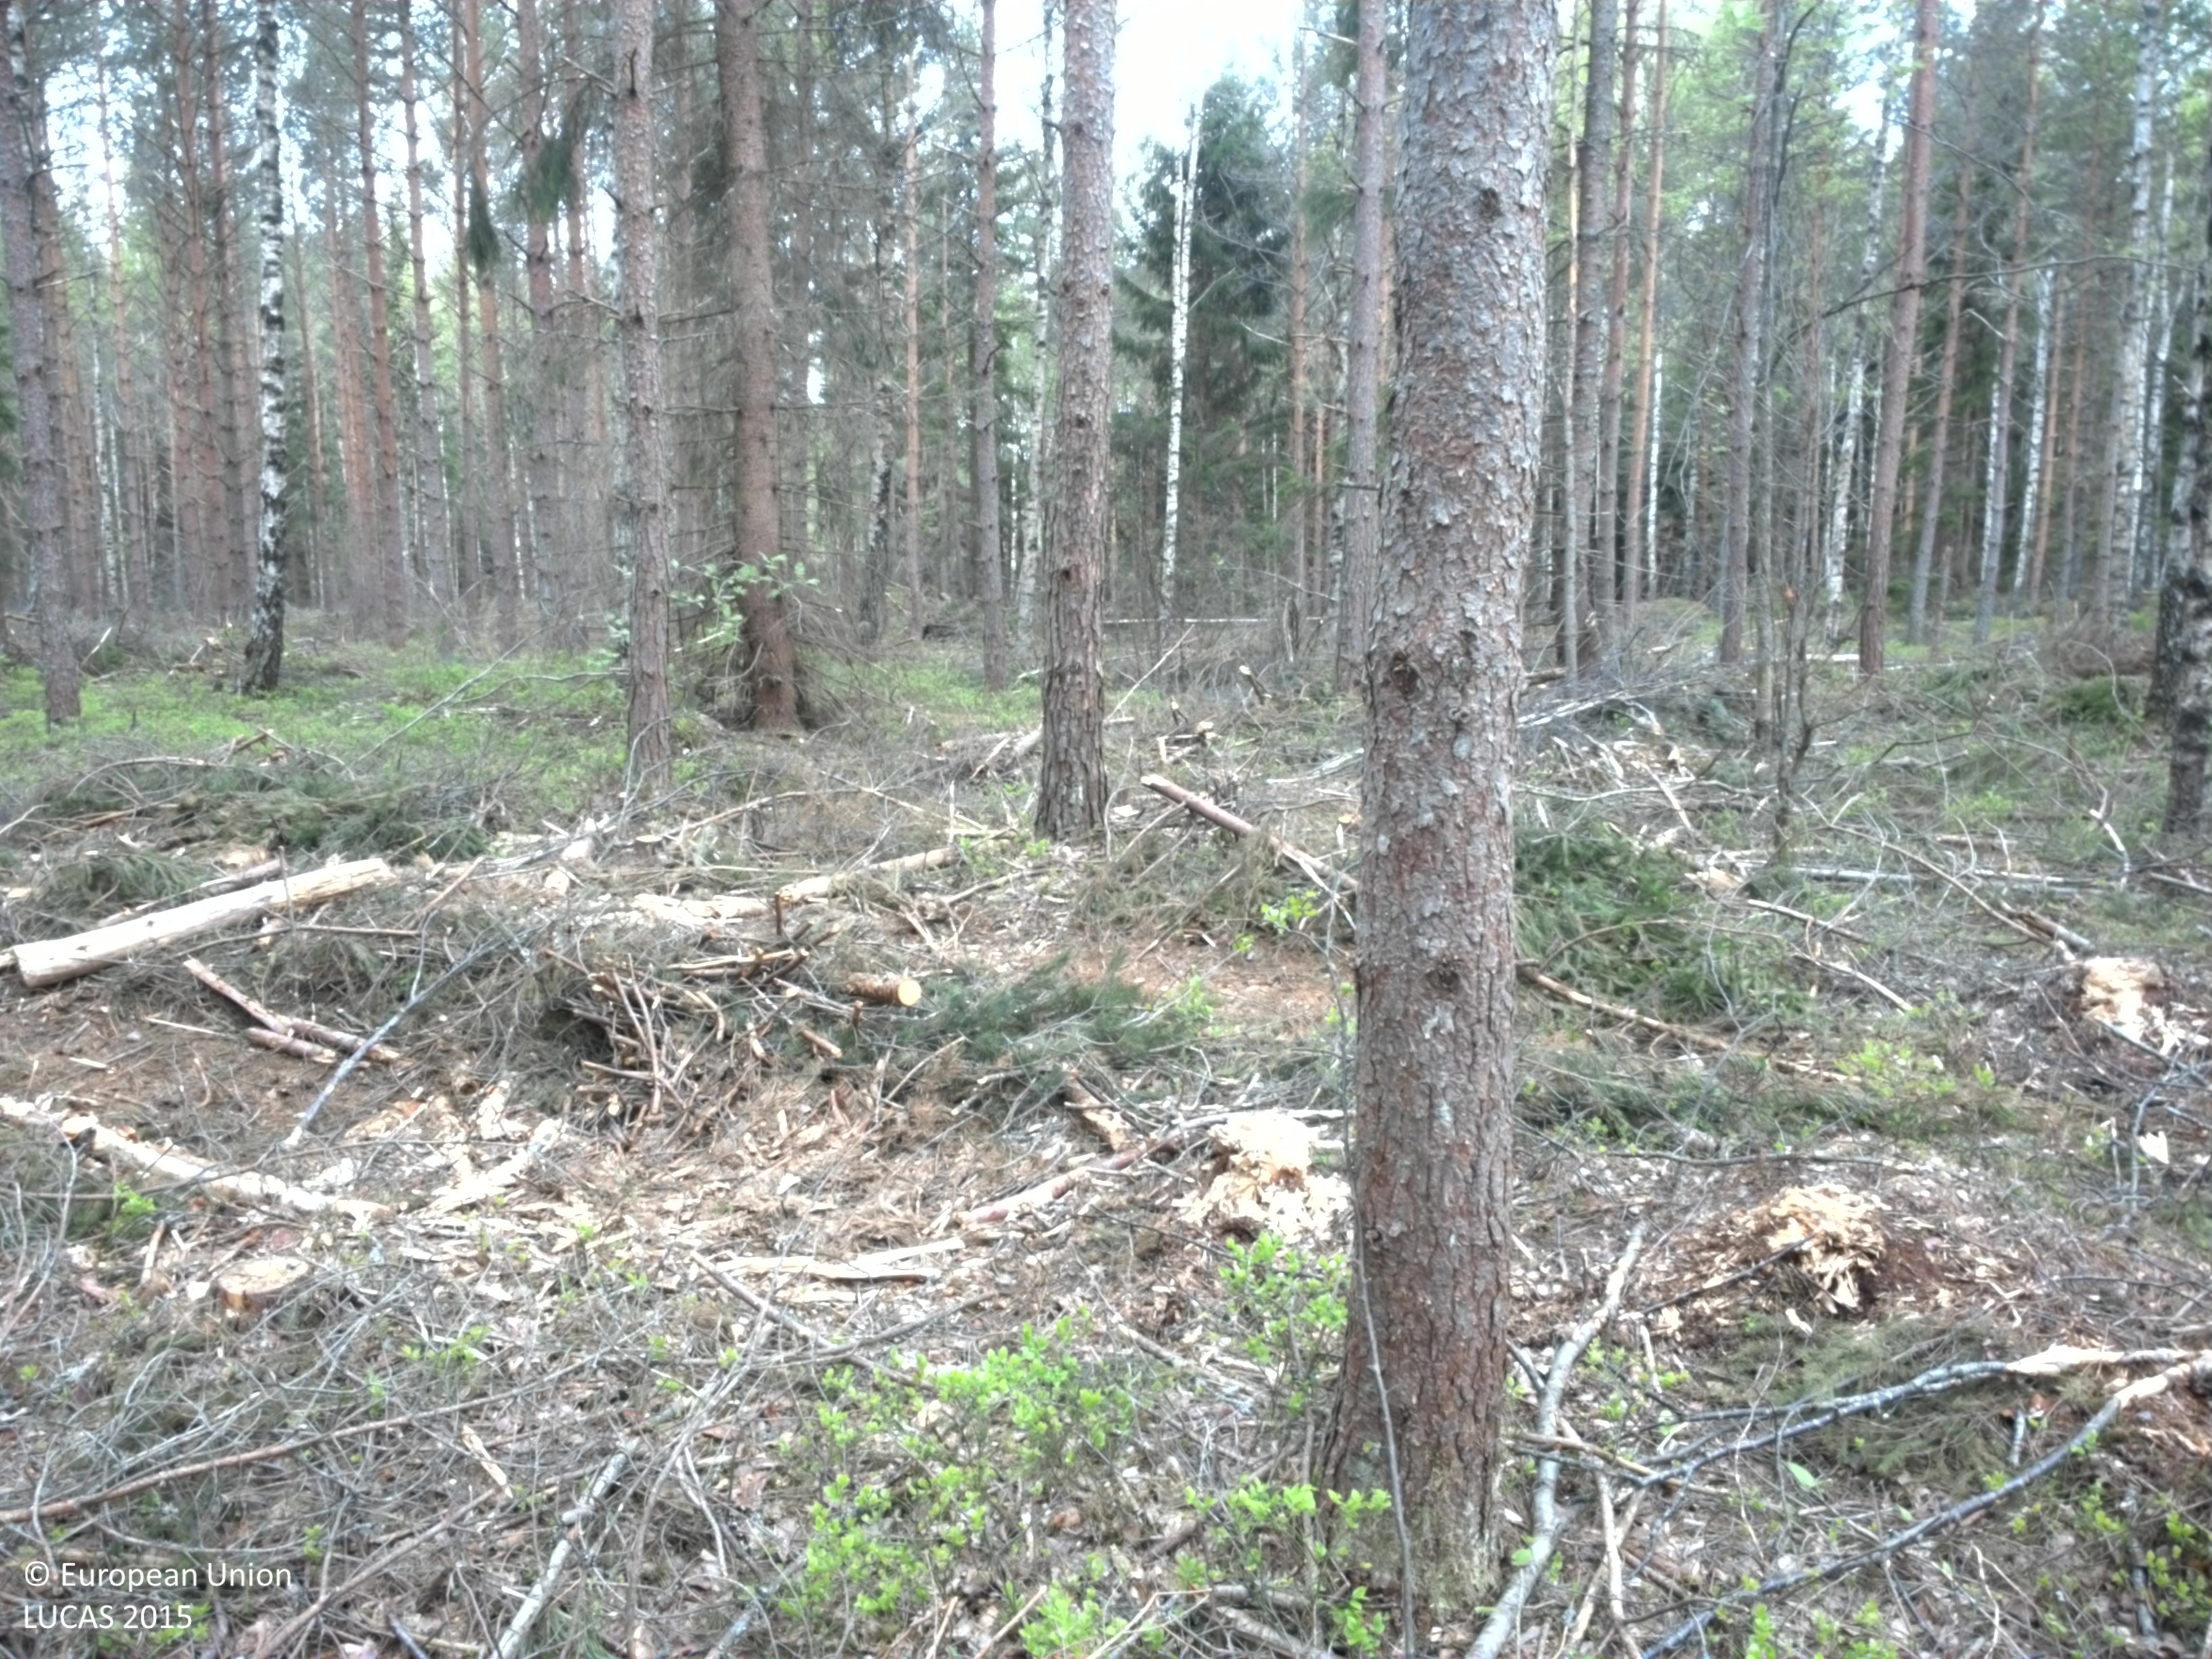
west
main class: Woodland
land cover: Other mixed woodland
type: boreal forest
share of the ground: > 75 %
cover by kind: coniferous forest trees 50 %, broadleaved forest trees 30 %, herbaceous plants 15 %, shrubs 5 %
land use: Forestry
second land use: Amenities, museums, leisure
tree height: > 5 m
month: May
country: SE
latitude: 59.2925
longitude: 14.0824
